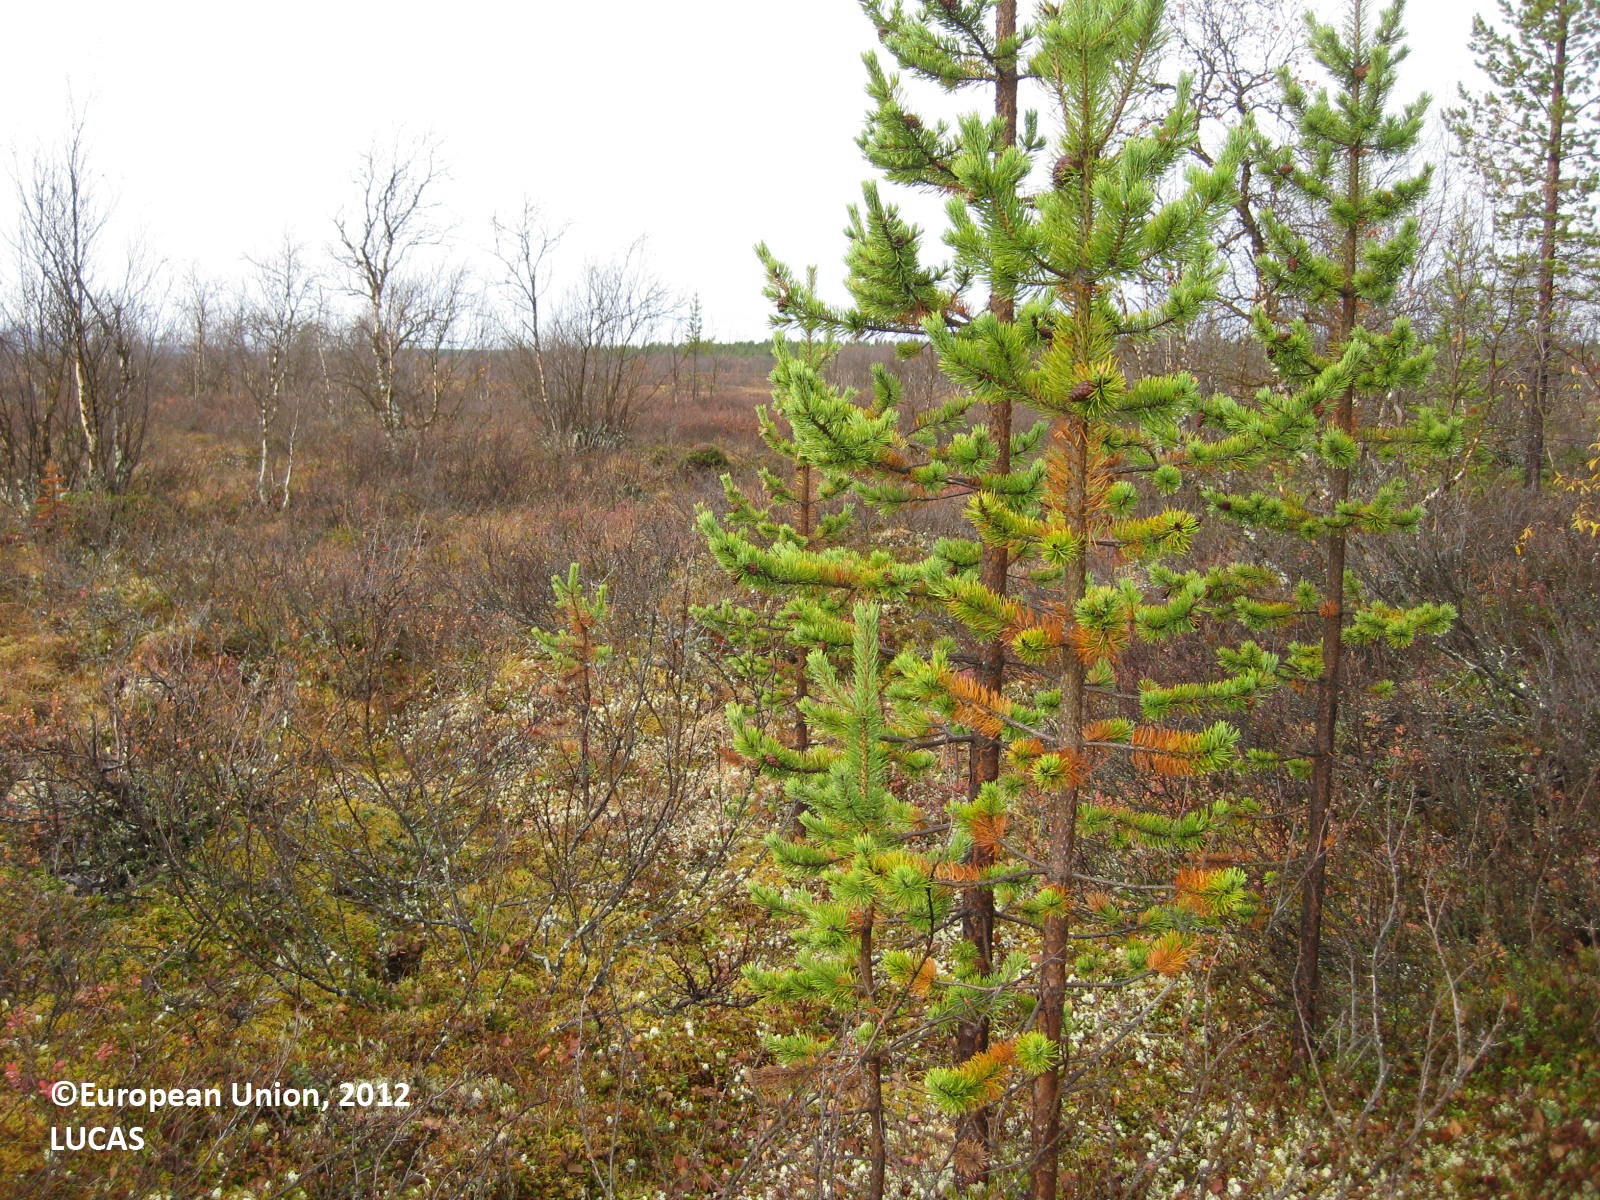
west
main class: Woodland
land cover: Pine dominated mixed woodland
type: boreal forest
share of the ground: 50 - 75 %
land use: Semi-natural and natural areas not in use
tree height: > 5 m
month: September
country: FI
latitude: 68.3999
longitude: 24.3028
